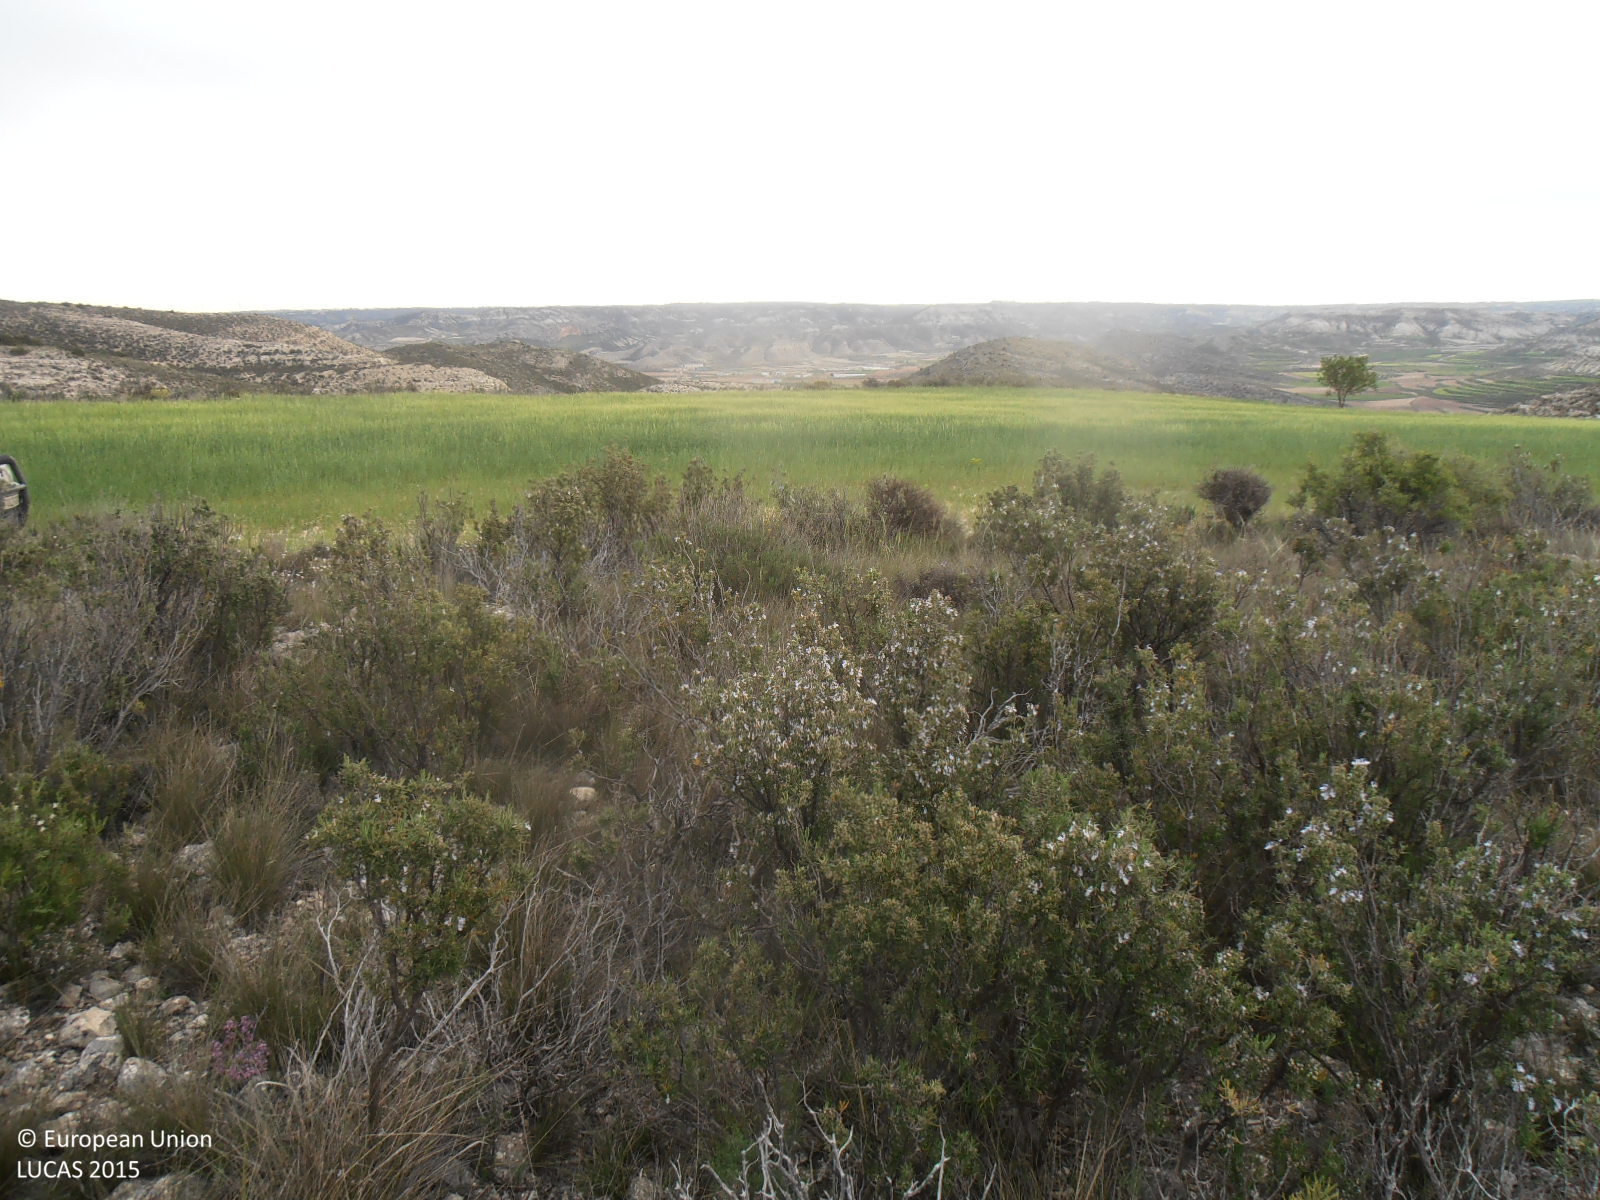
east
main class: Shrubland
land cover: Shrubland without tree cover
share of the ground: > 75 %
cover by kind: shrubs 90 %, herbaceous plants 10 %
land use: Semi-natural and natural areas not in use
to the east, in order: Shrubland without tree cover; Barley; Shrubland without tree cover; Shrubland with sparse tree cover; Shrubland without tree cover; Nuts trees; Dry stone walls; Nuts trees; Dry stone walls; Nuts trees; Shrubland without tree cover
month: May
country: ES
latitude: 41.4495
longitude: -1.0216
